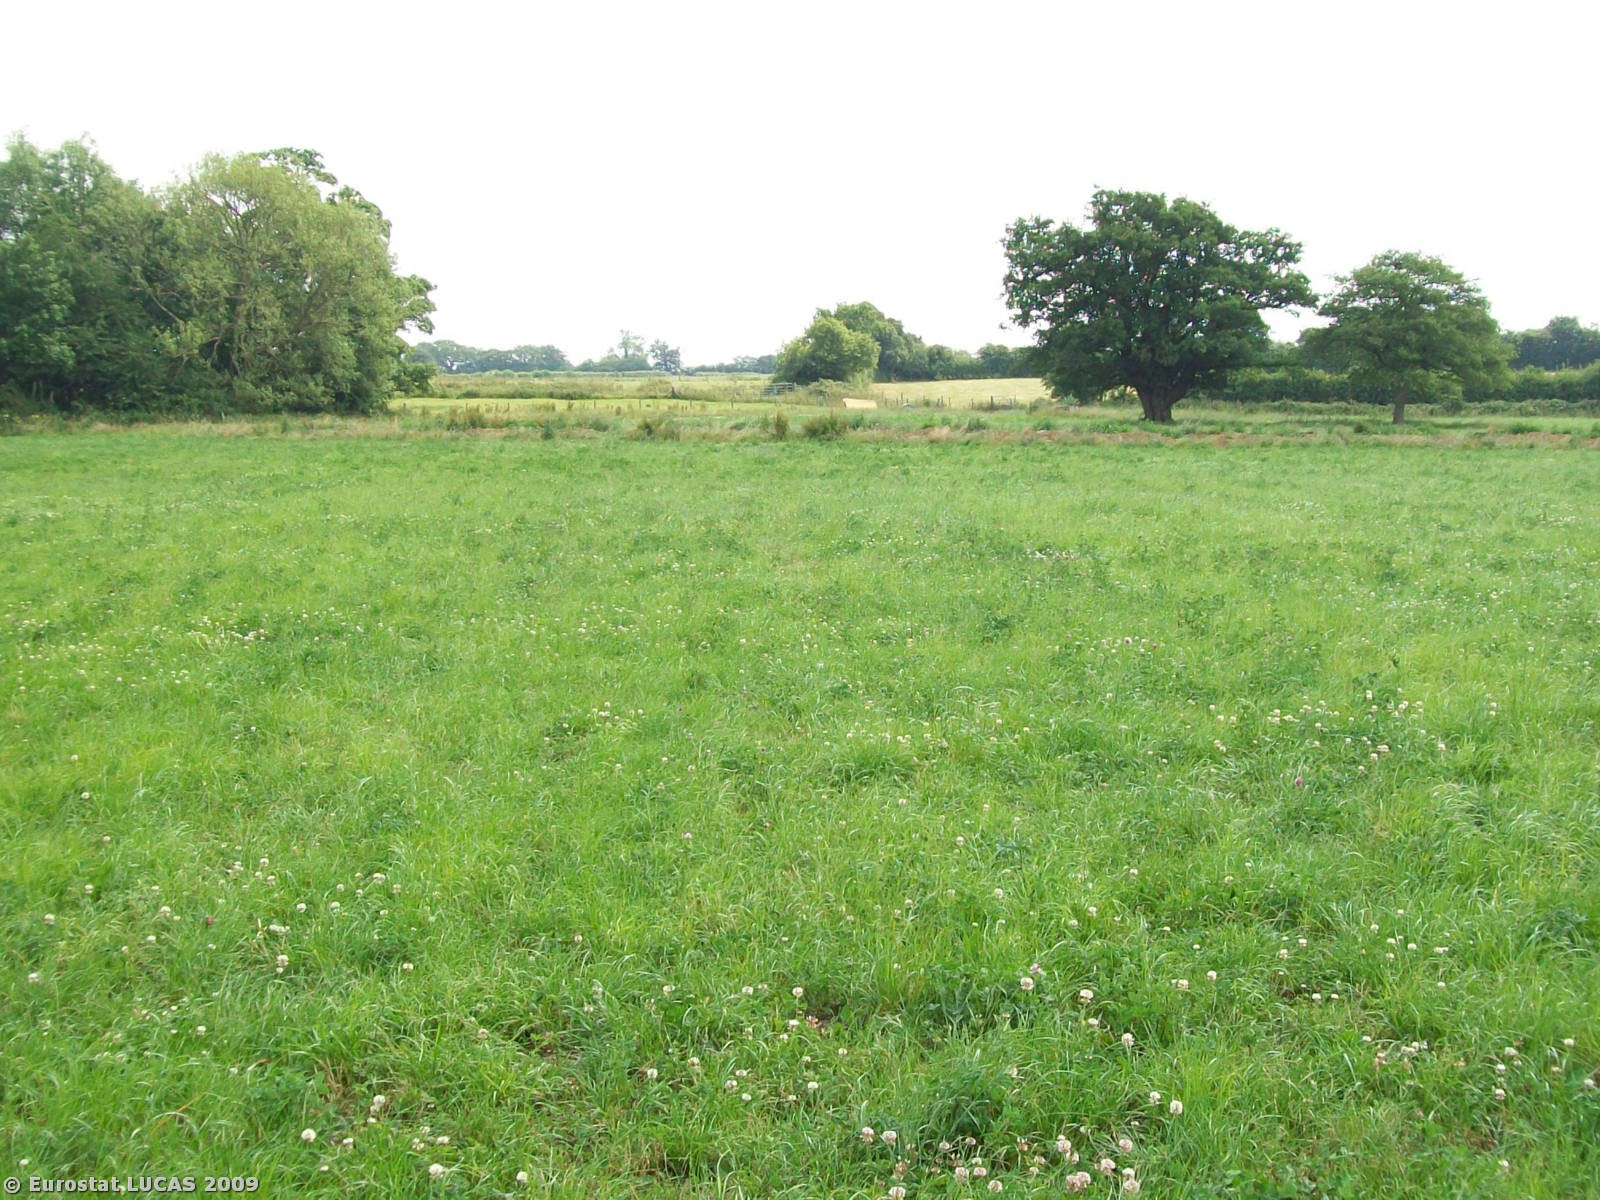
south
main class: Grassland
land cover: Grassland without tree/shrub cover
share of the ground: > 75 %
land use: Agriculture (excluding fallow land and kitchen gardens)
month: June
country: GB
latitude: 51.2838
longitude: -2.2639
